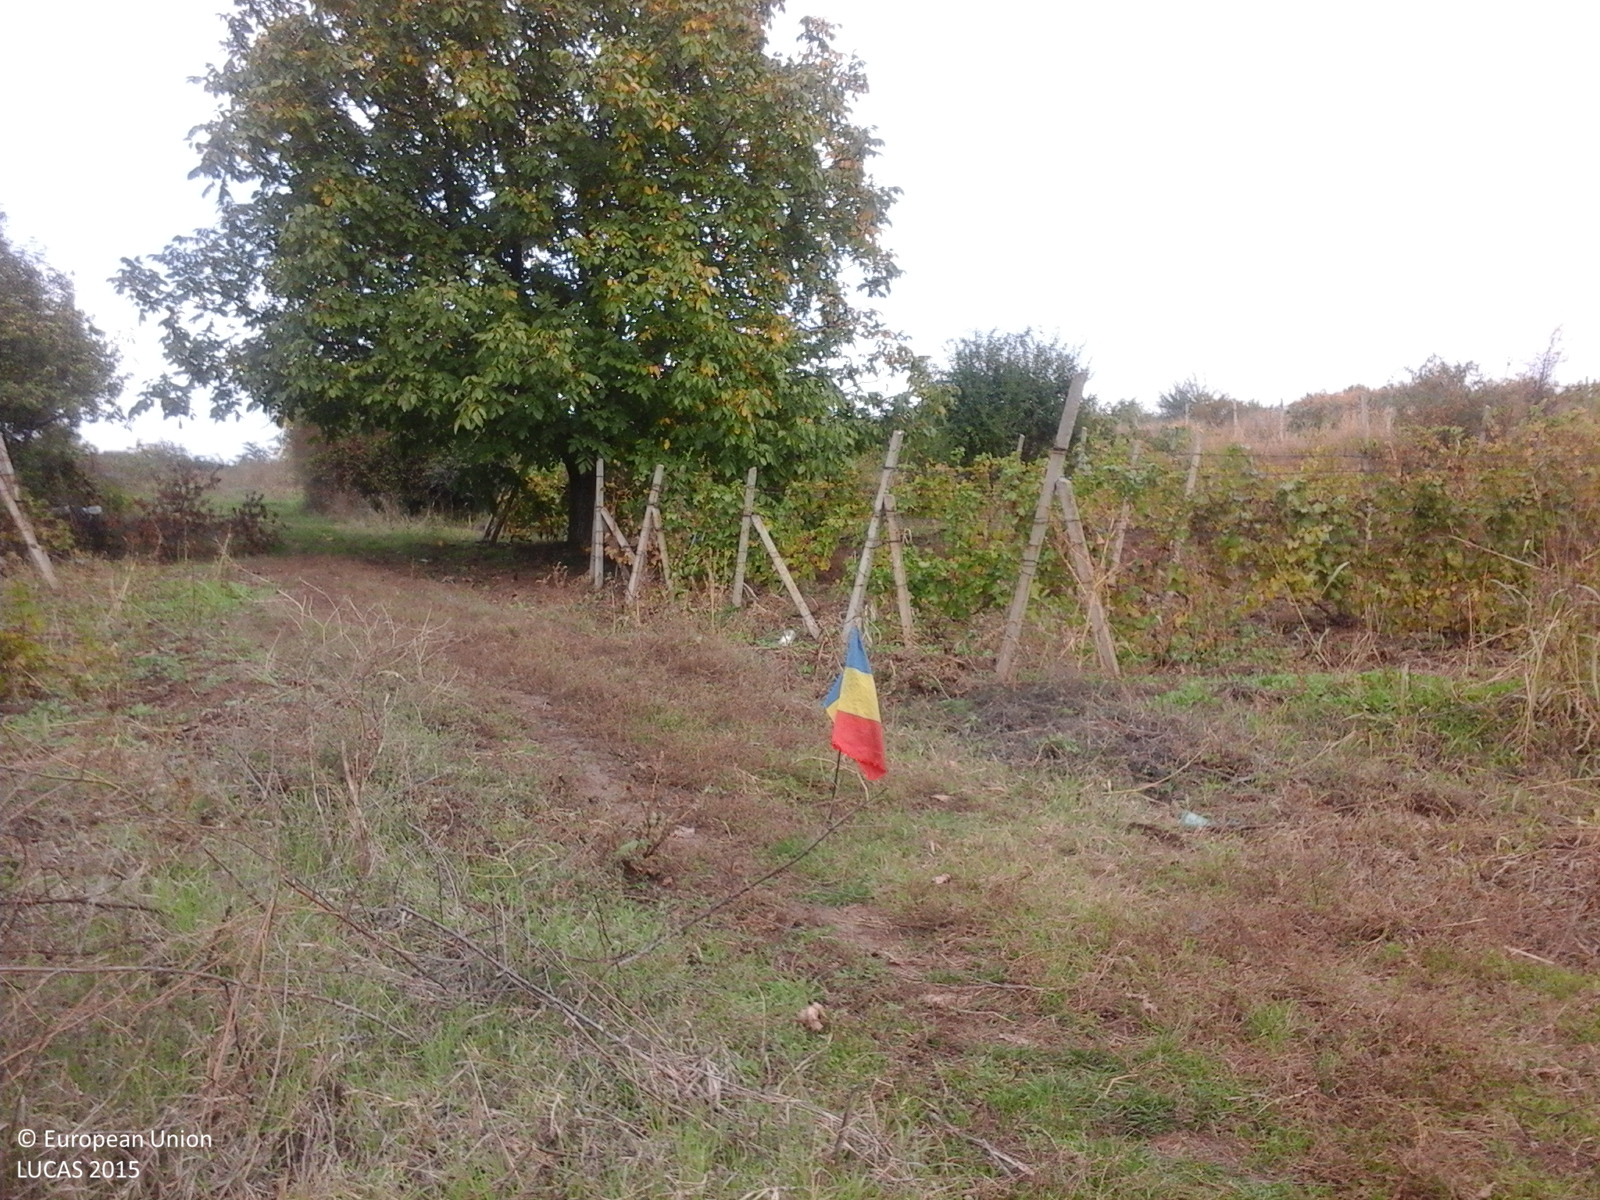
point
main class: Cropland
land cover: Vineyards
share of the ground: 25 - 50 %
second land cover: Grassland without tree/shrub cover
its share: > 75 %
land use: Agriculture (excluding fallow land and kitchen gardens)
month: October
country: RO
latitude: 45.0407
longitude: 26.3802
